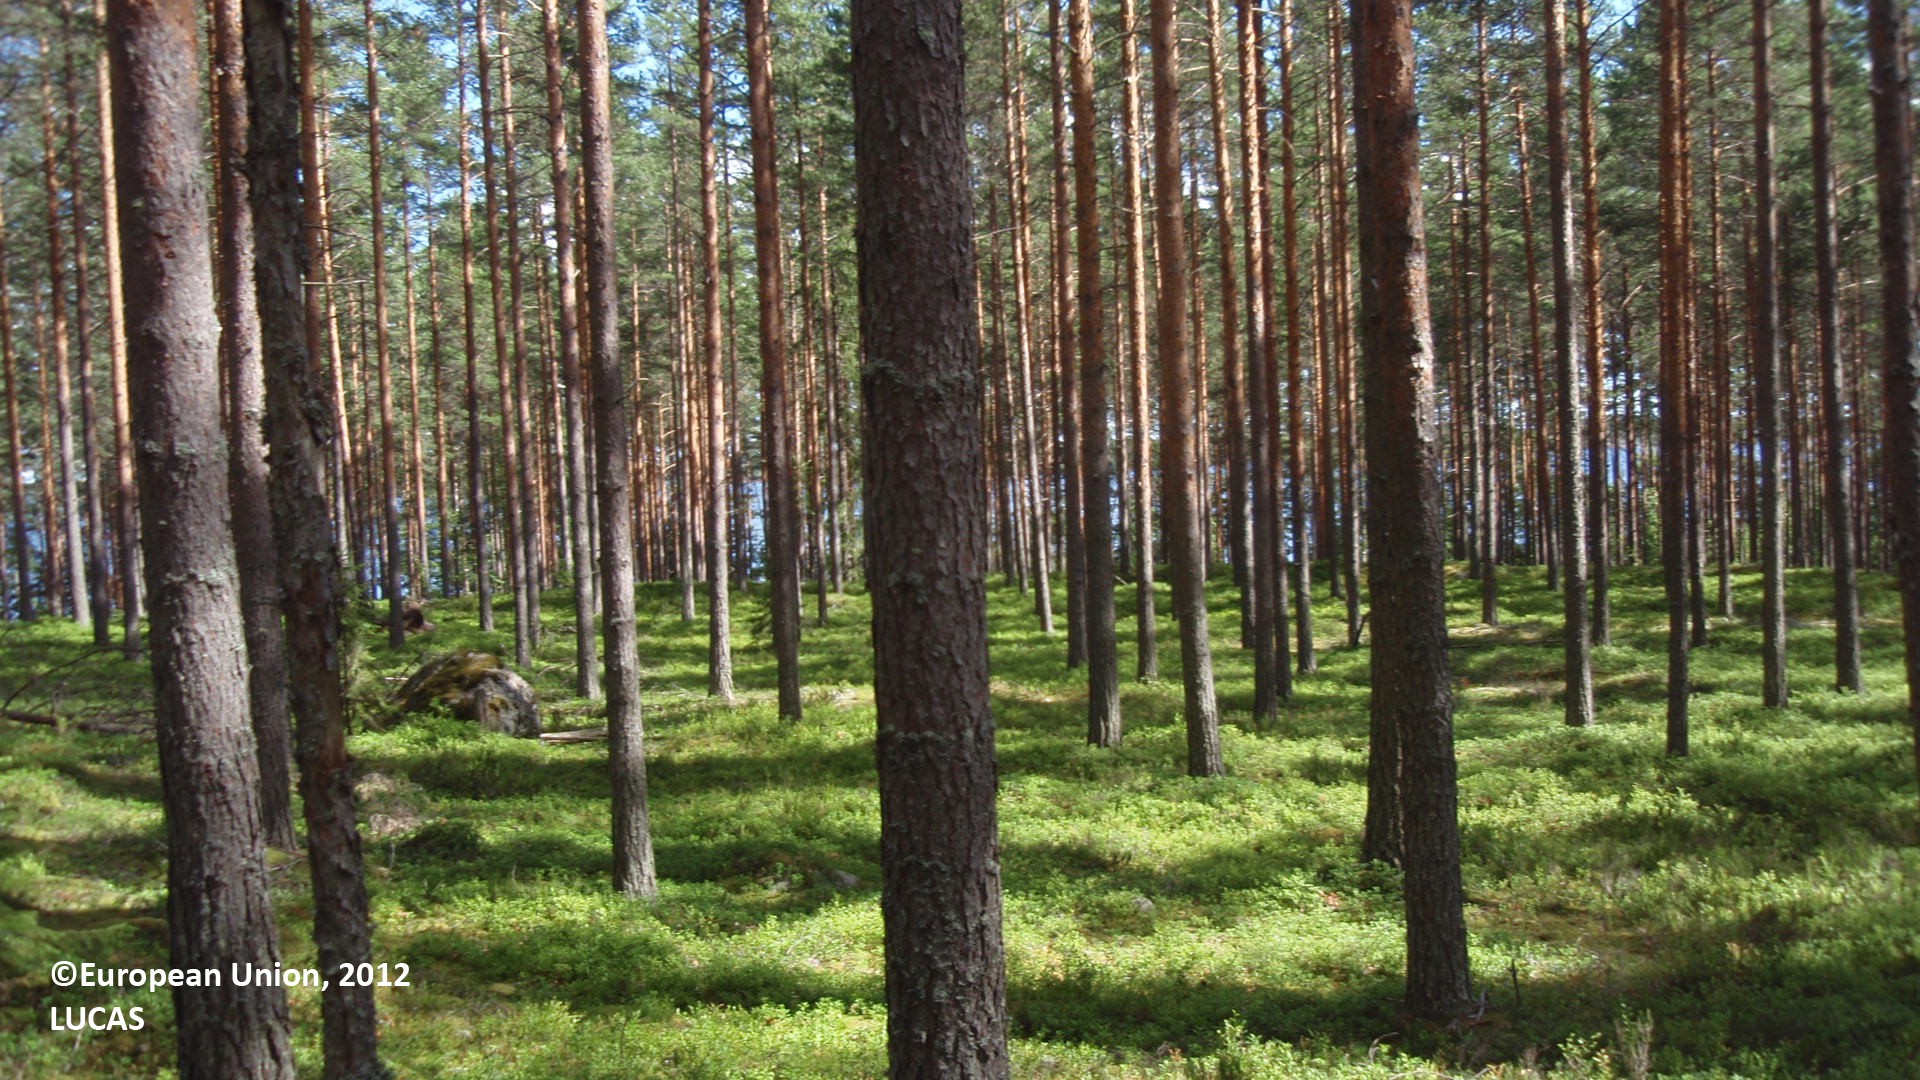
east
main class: Woodland
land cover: Pine dominated coniferous woodland
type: boreal forest
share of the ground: 25 - 50 %
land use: Forestry
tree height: > 5 m
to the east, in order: Pine dominated coniferous woodland; Broadleaved woodland; Inland marshes; Inland water bodies
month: July
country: FI
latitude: 61.6618
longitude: 27.8447
